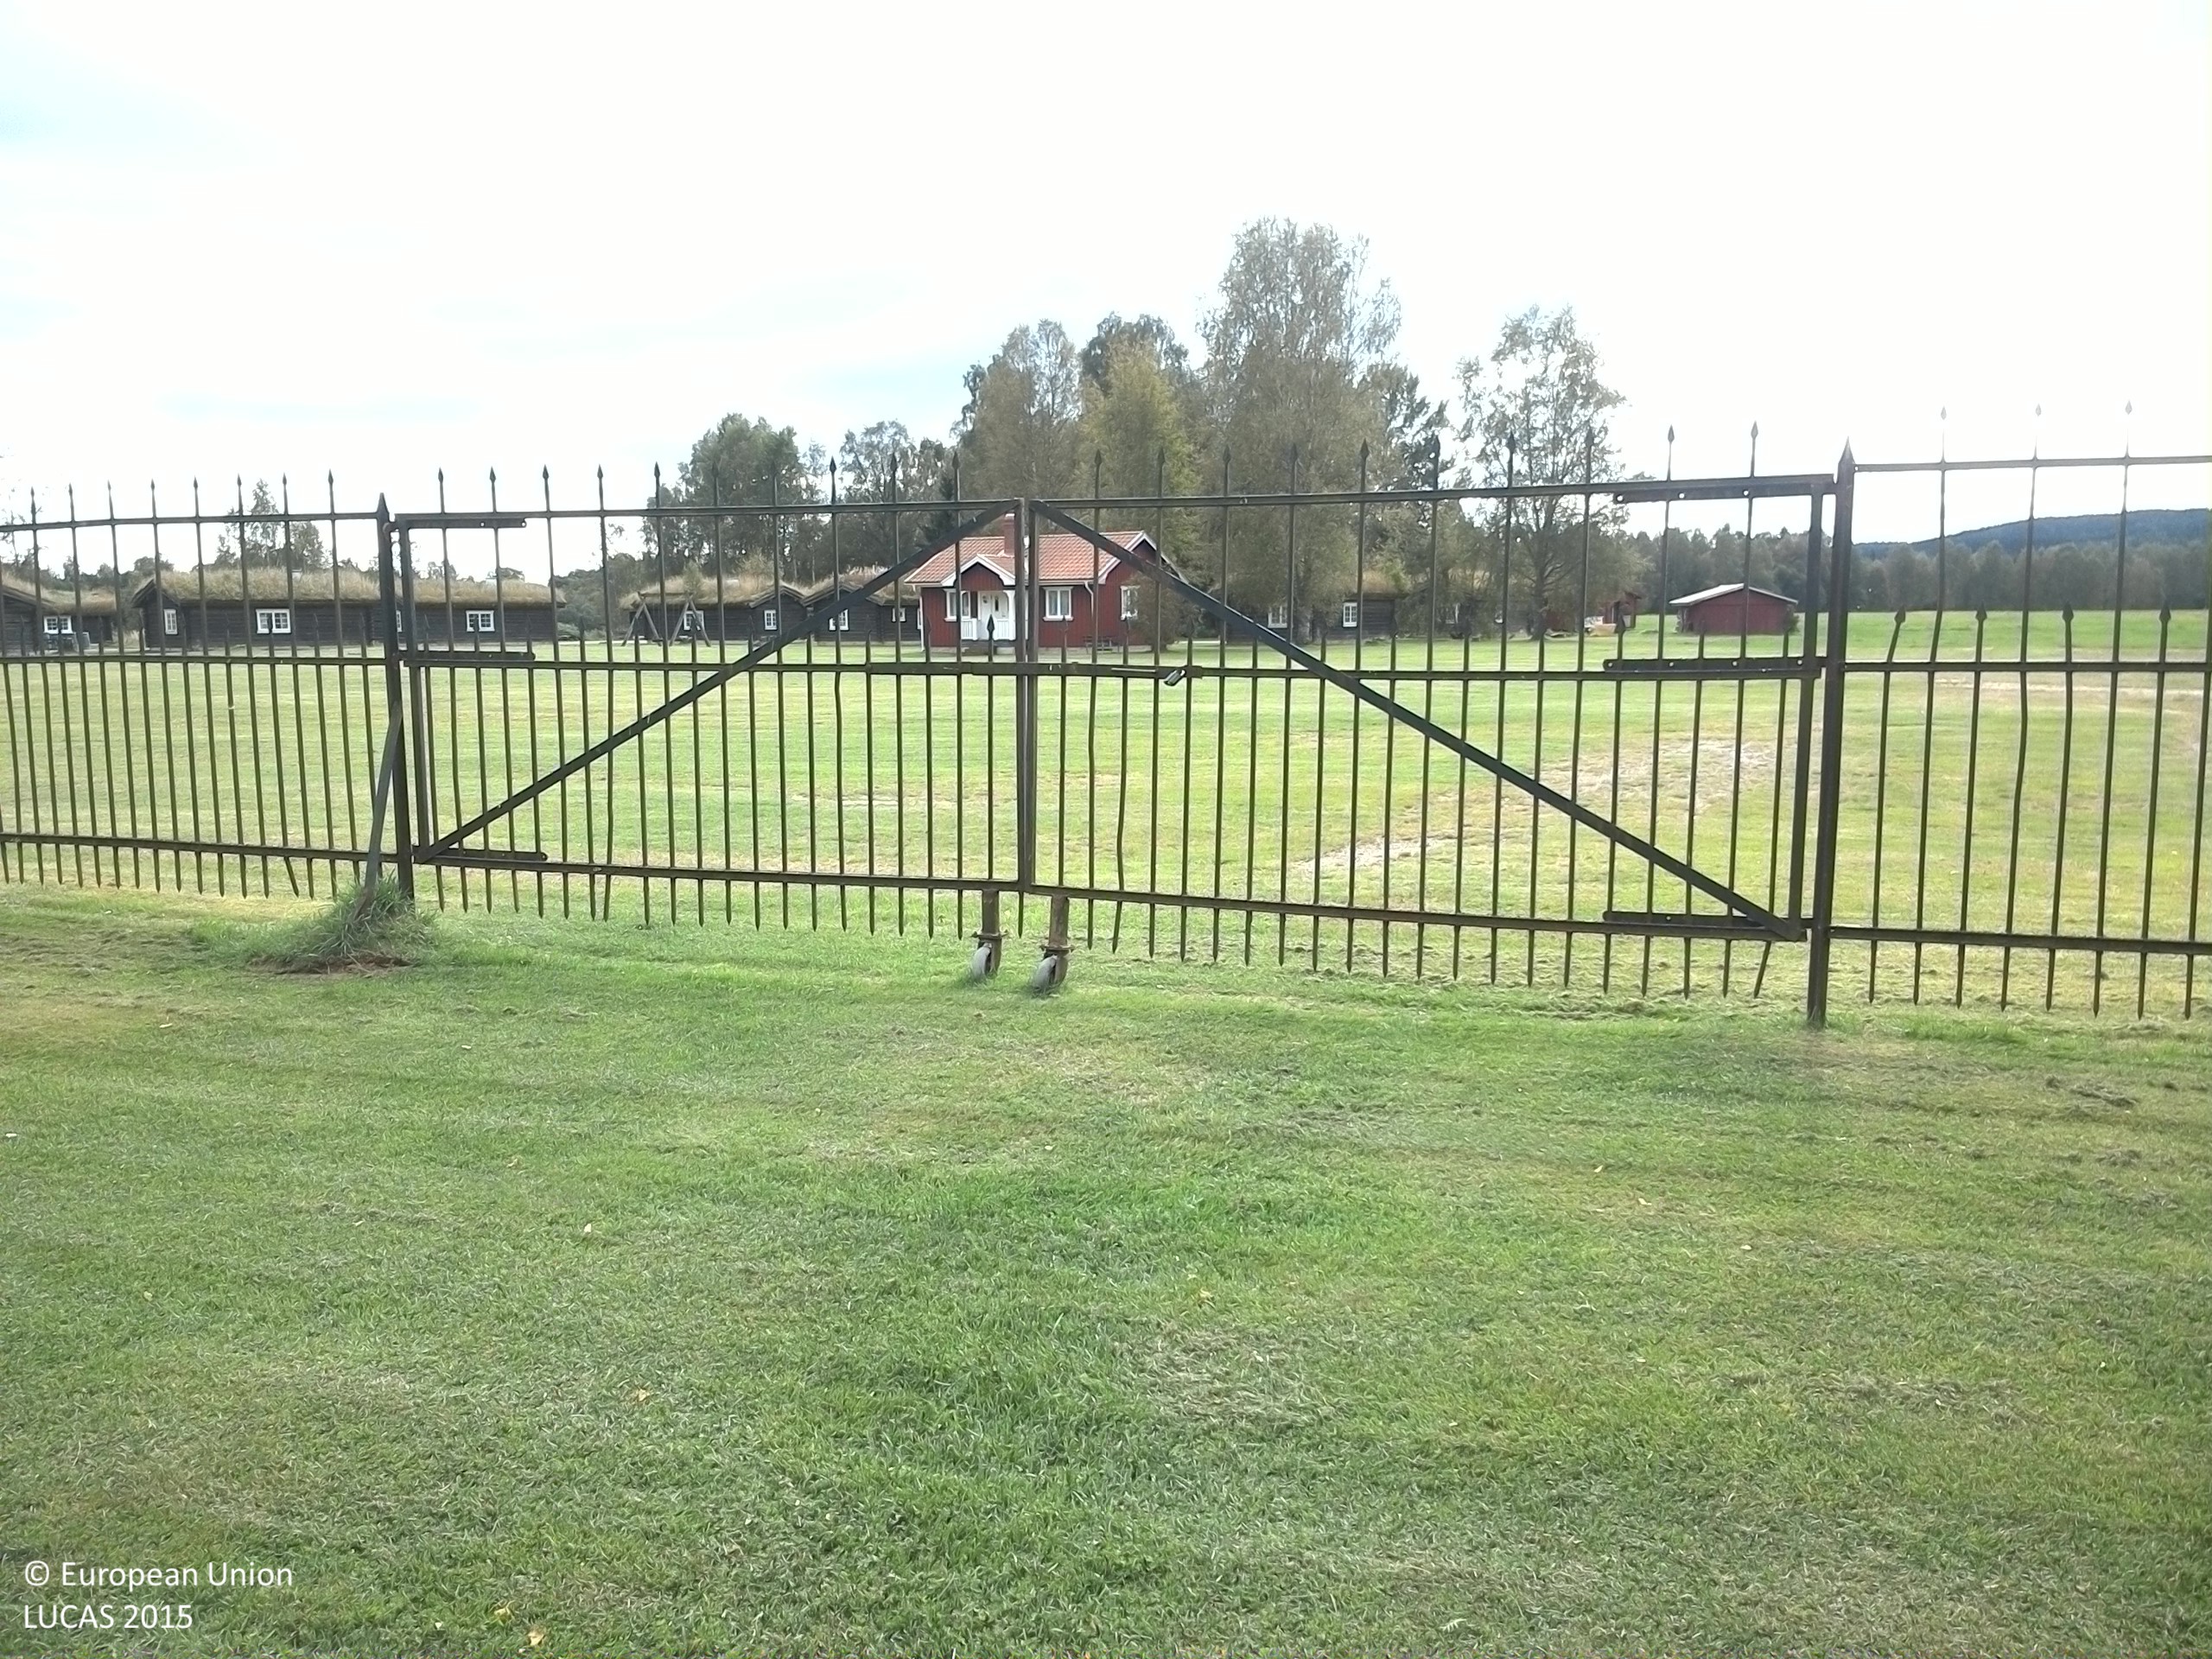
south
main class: Grassland
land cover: Grassland without tree/shrub cover
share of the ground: > 75 %
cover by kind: herbaceous plants 95 %, consolidated bare surface 5 %
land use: Amenities, museums, leisure
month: September
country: SE
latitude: 59.7778
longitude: 13.4645
